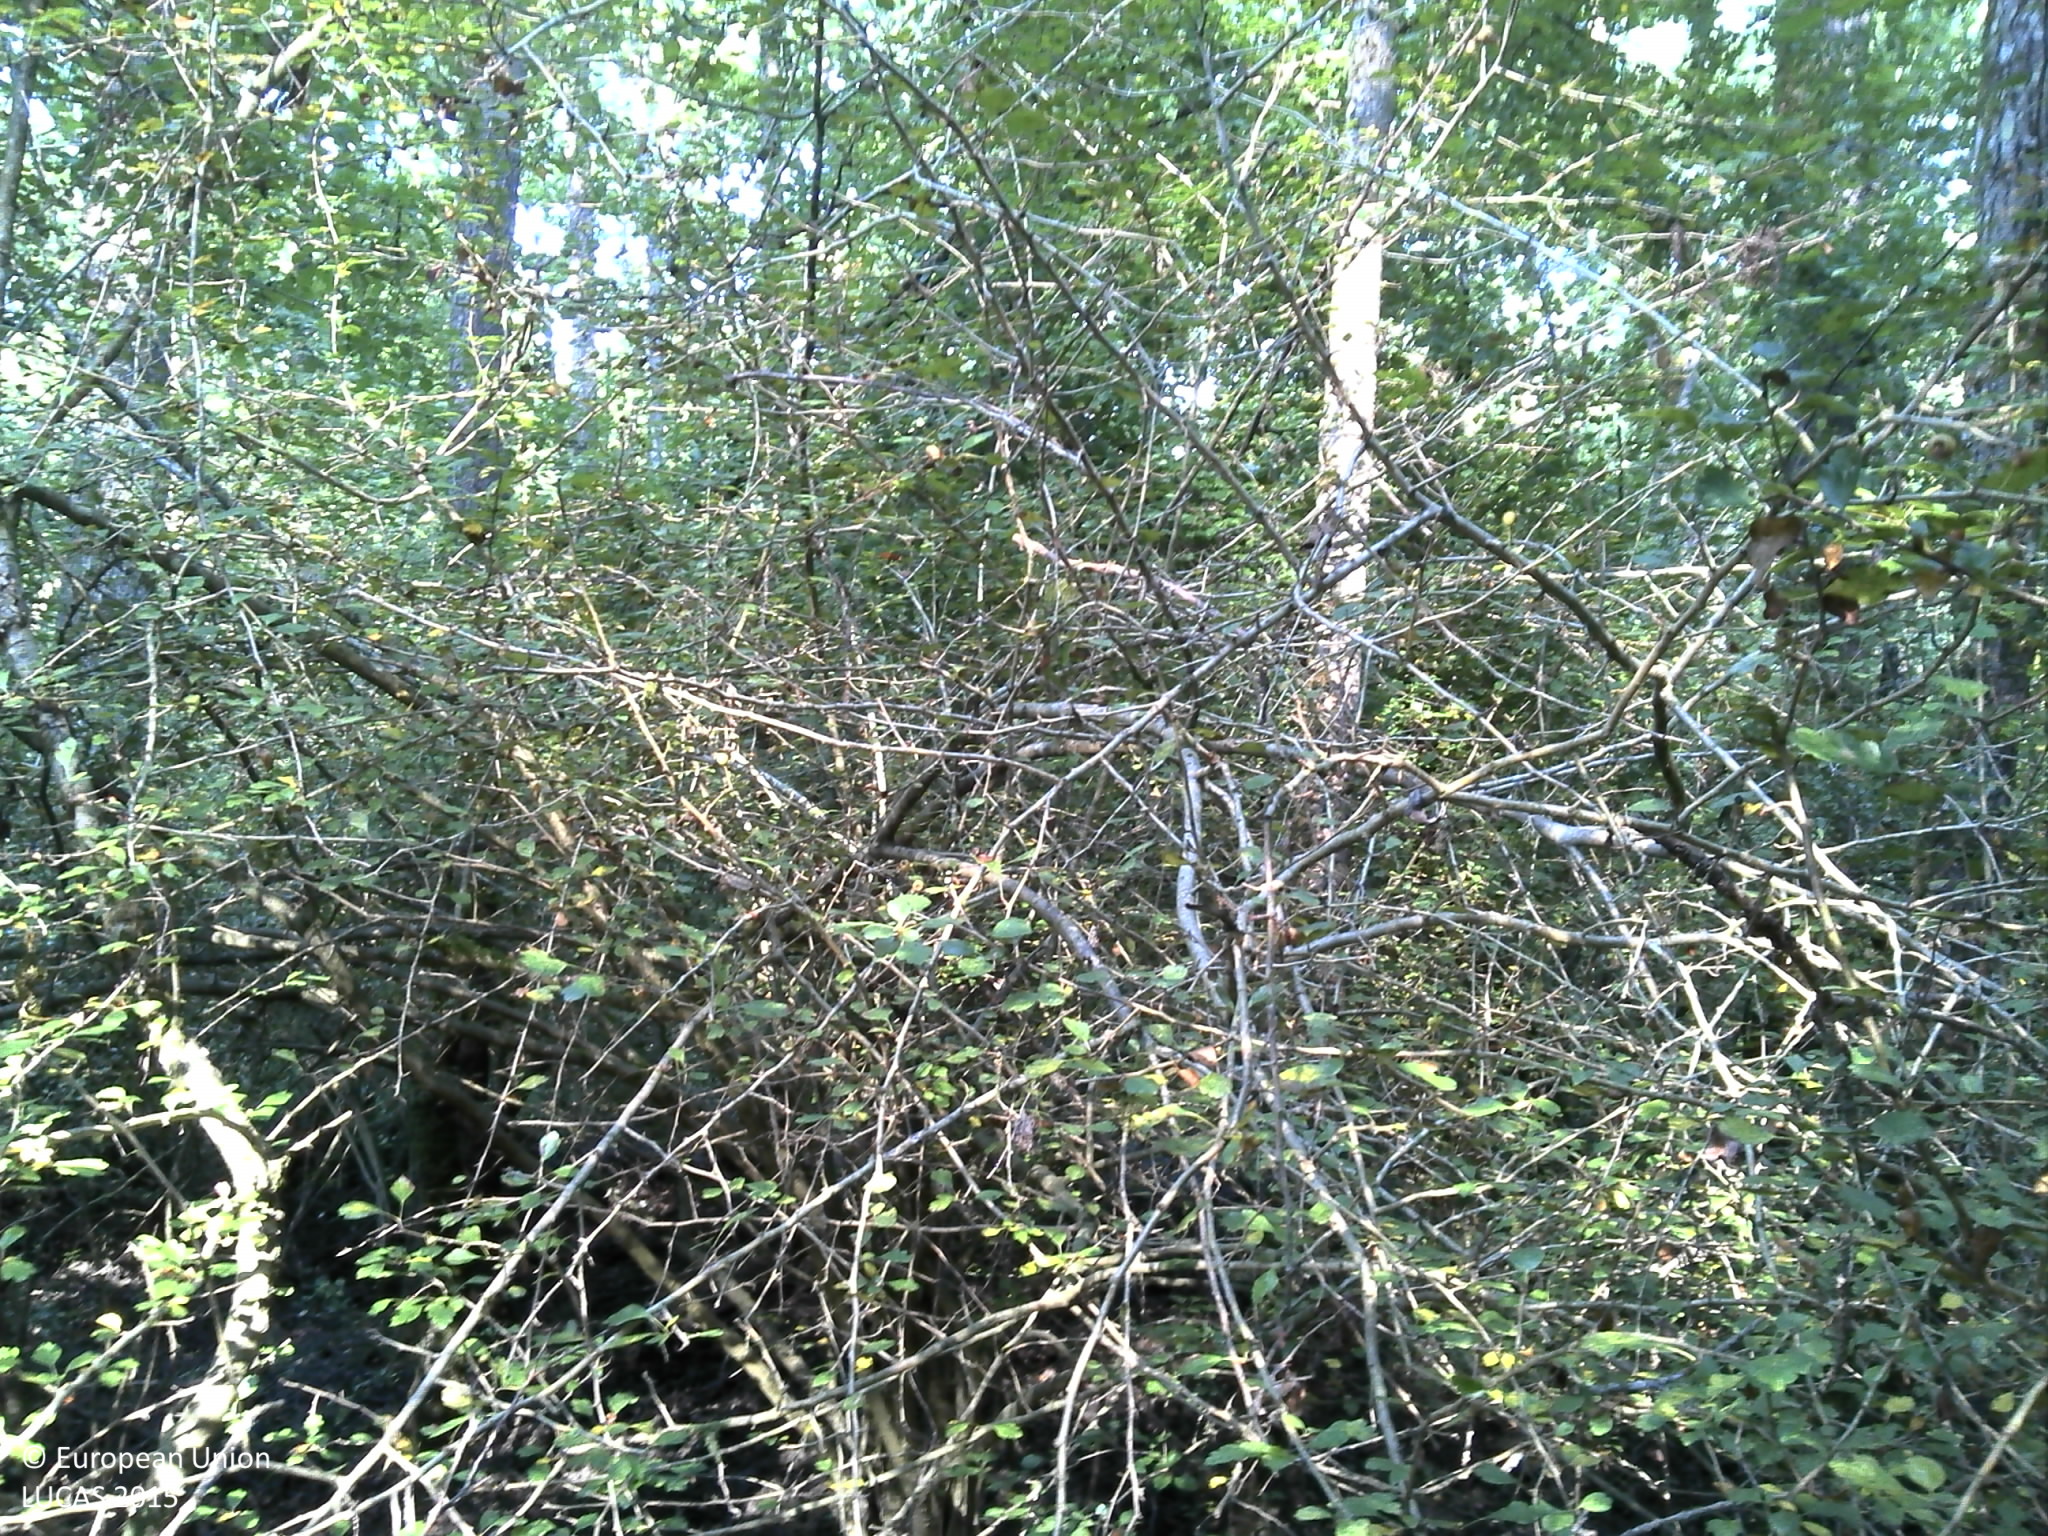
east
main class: Woodland
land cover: Broadleaved woodland
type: acidophilous oak and oak-birch forest
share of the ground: > 75 %
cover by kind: broadleaved forest trees 100 %
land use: Forestry
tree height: > 5 m
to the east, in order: Broadleaved woodland
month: August
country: HR
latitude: 45.5519
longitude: 16.2873
